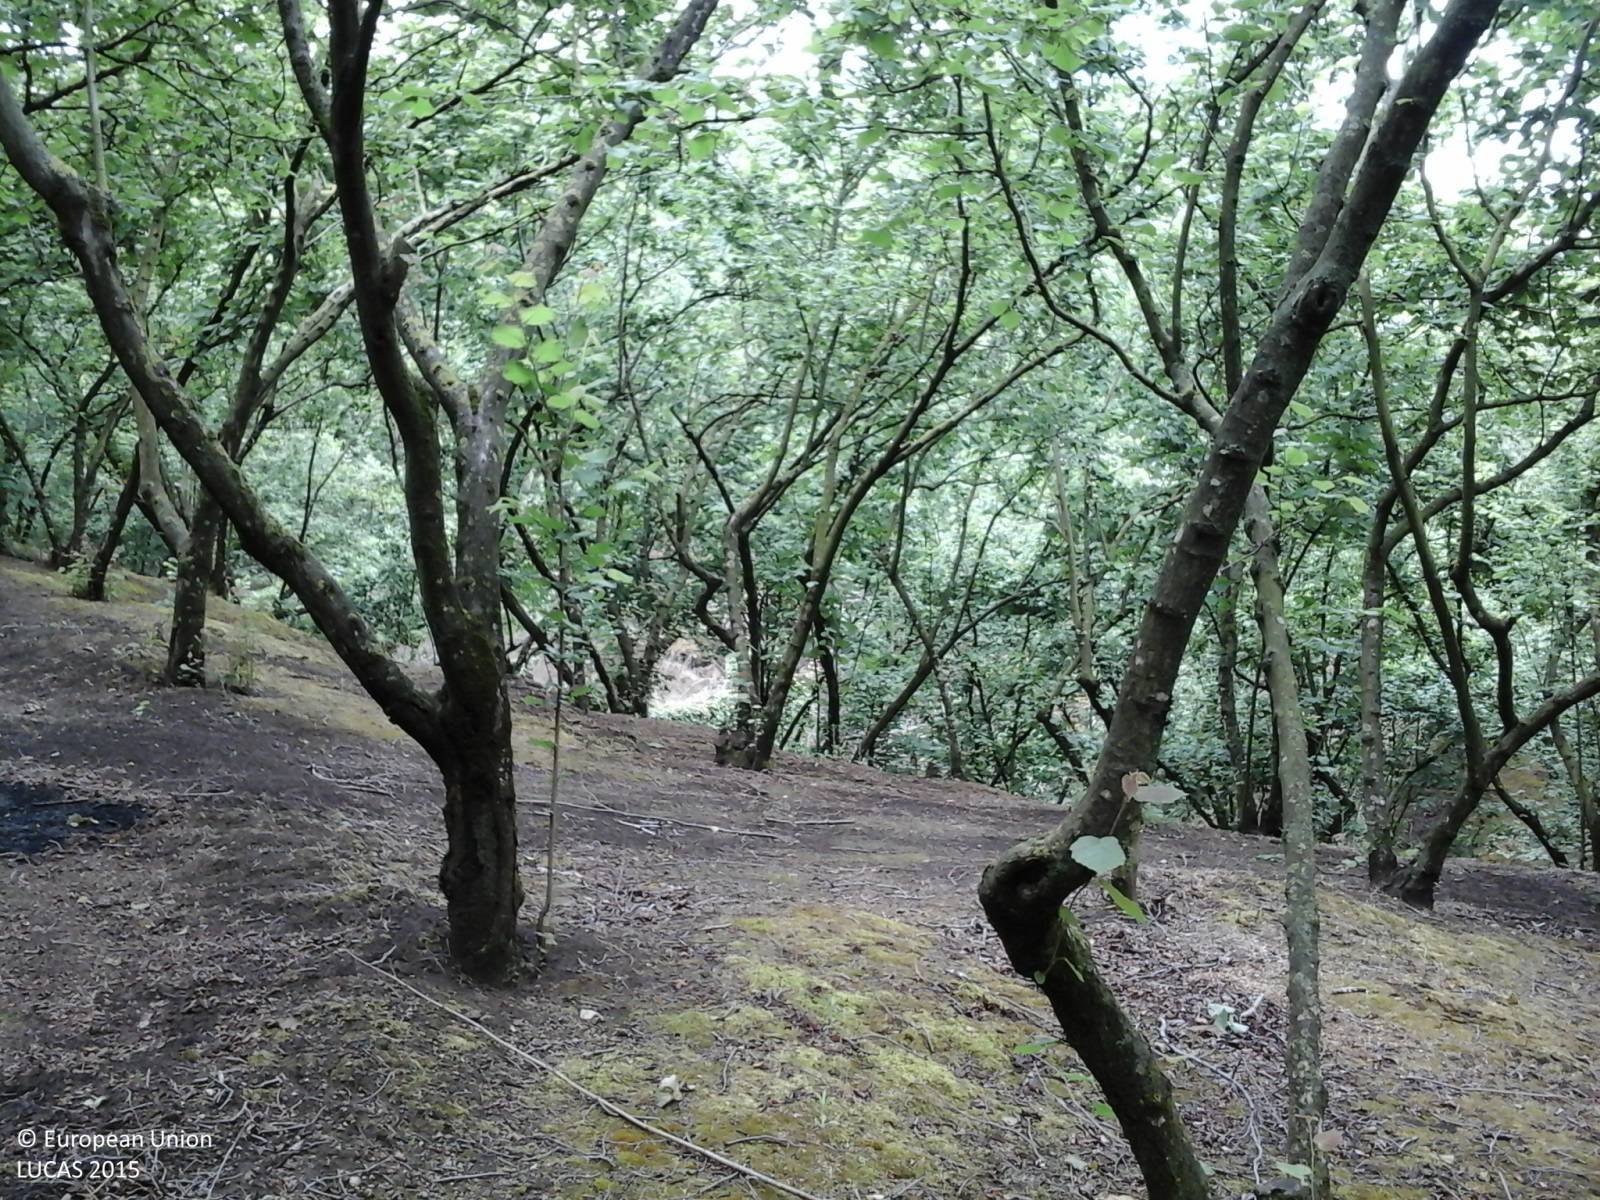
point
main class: Cropland
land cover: Nuts trees
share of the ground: > 75 %
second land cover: Spontaneously vegetated surfaces
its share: < 10 %
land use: Agriculture (excluding fallow land and kitchen gardens)
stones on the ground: < 10 %
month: May
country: IT
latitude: 40.9396
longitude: 14.5783
